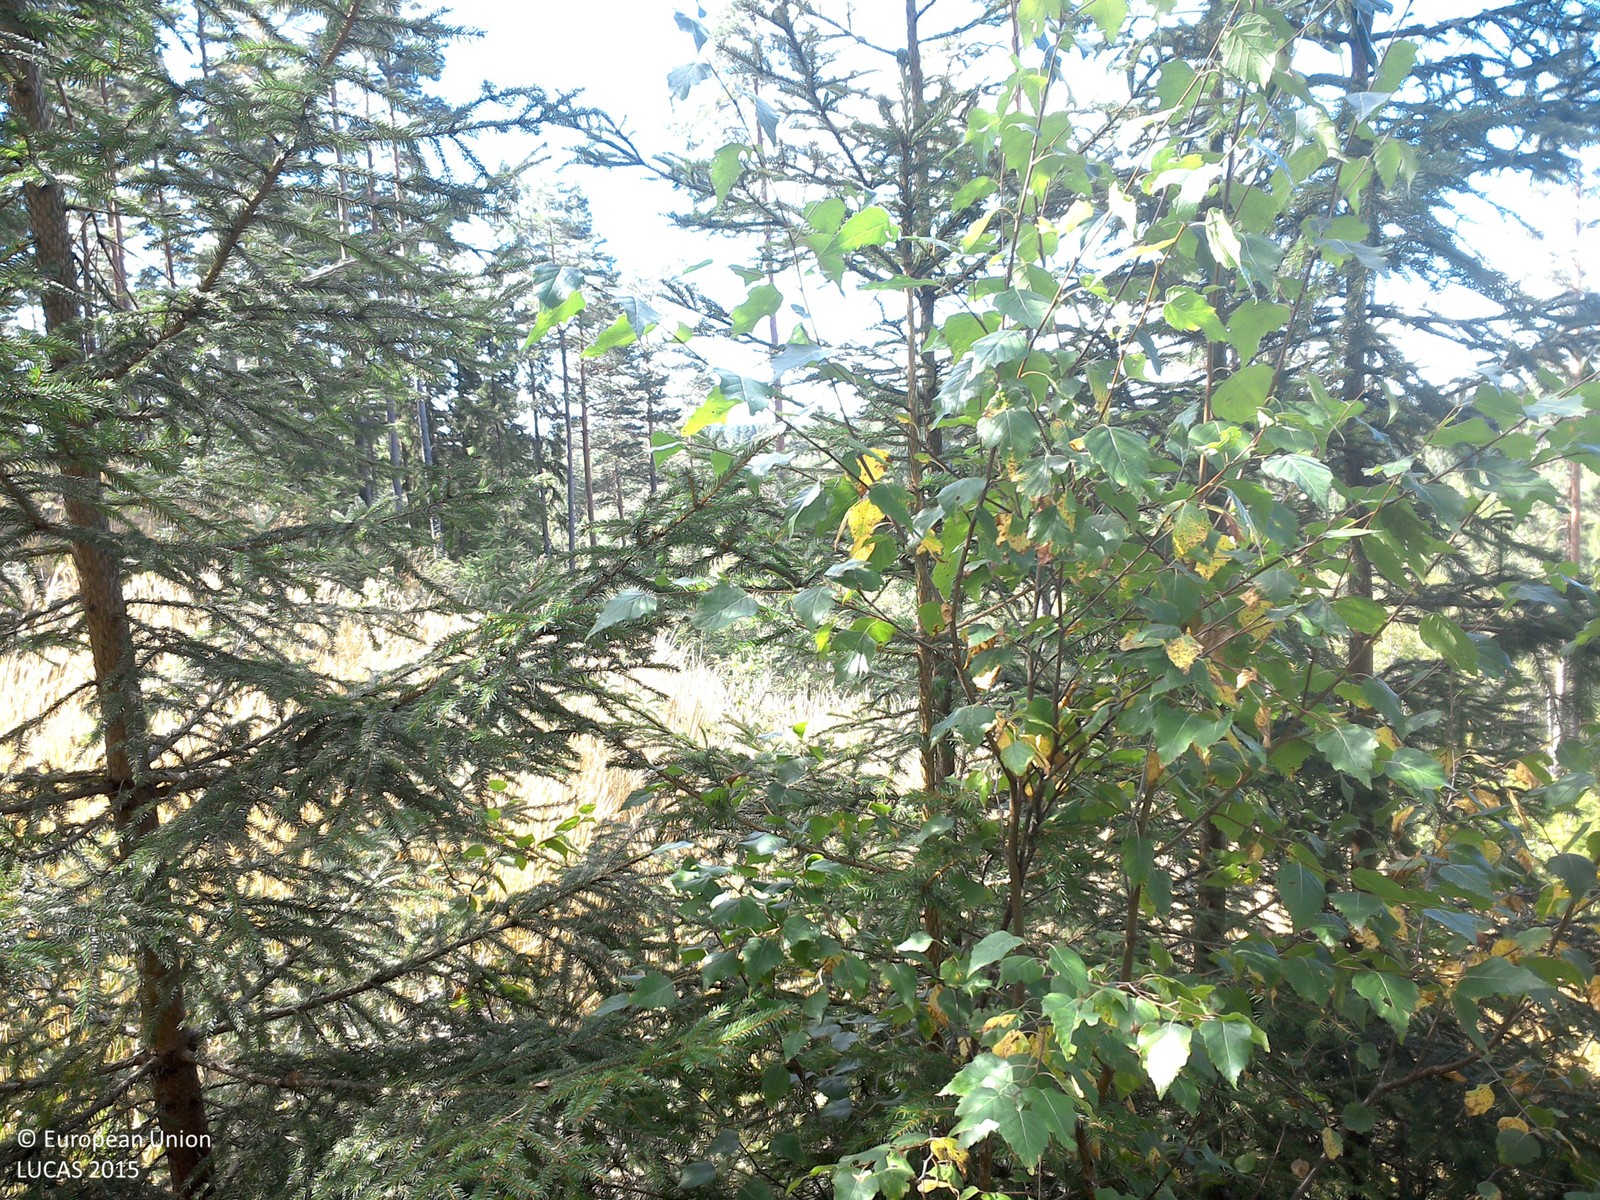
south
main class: Woodland
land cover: Spruce dominated mixed woodland
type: boreal forest
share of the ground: 50 - 75 %
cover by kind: coniferous forest trees 50 %, broadleaved forest trees 20 %, herbaceous plants 15 %, lichens and mosses 15 %
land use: Forestry
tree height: < 5 m
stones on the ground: < 10 %
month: August
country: SE
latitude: 58.0982
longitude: 15.2713
